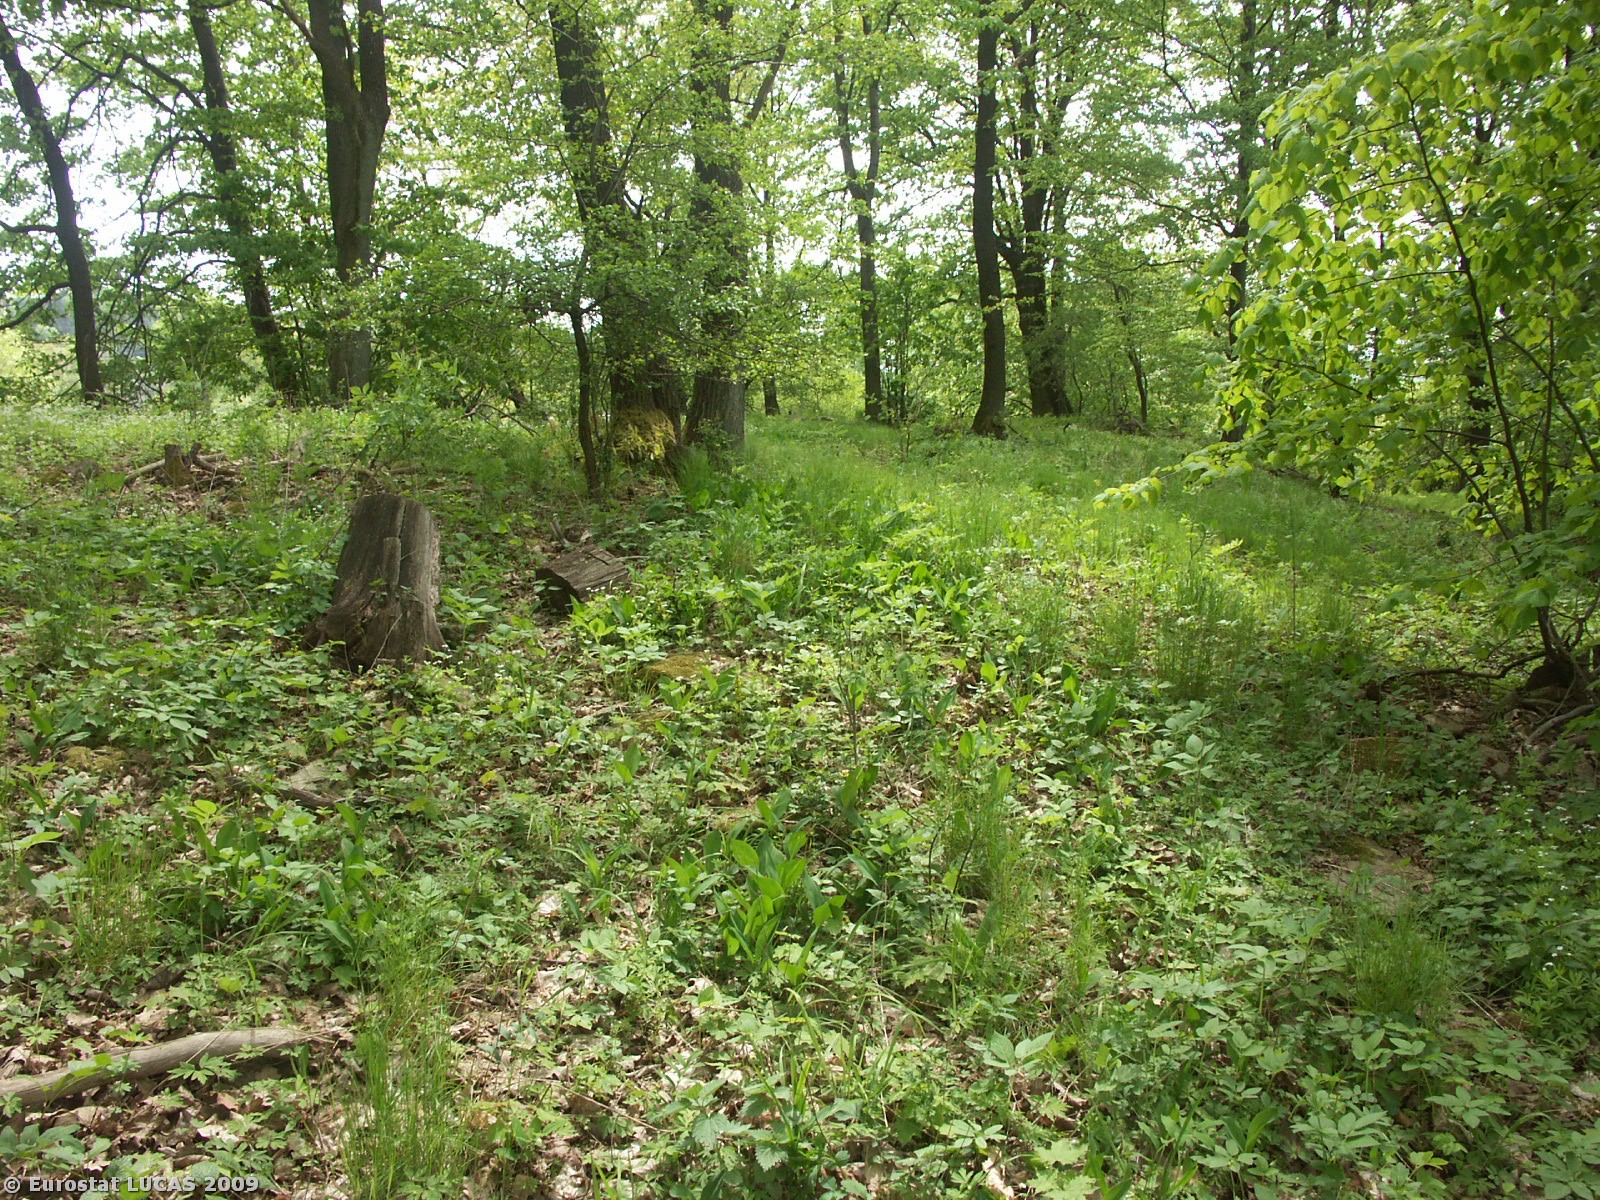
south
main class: Woodland
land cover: Broadleaved woodland
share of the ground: > 75 %
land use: Forestry
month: May
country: CZ
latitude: 49.7498
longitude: 17.3255
